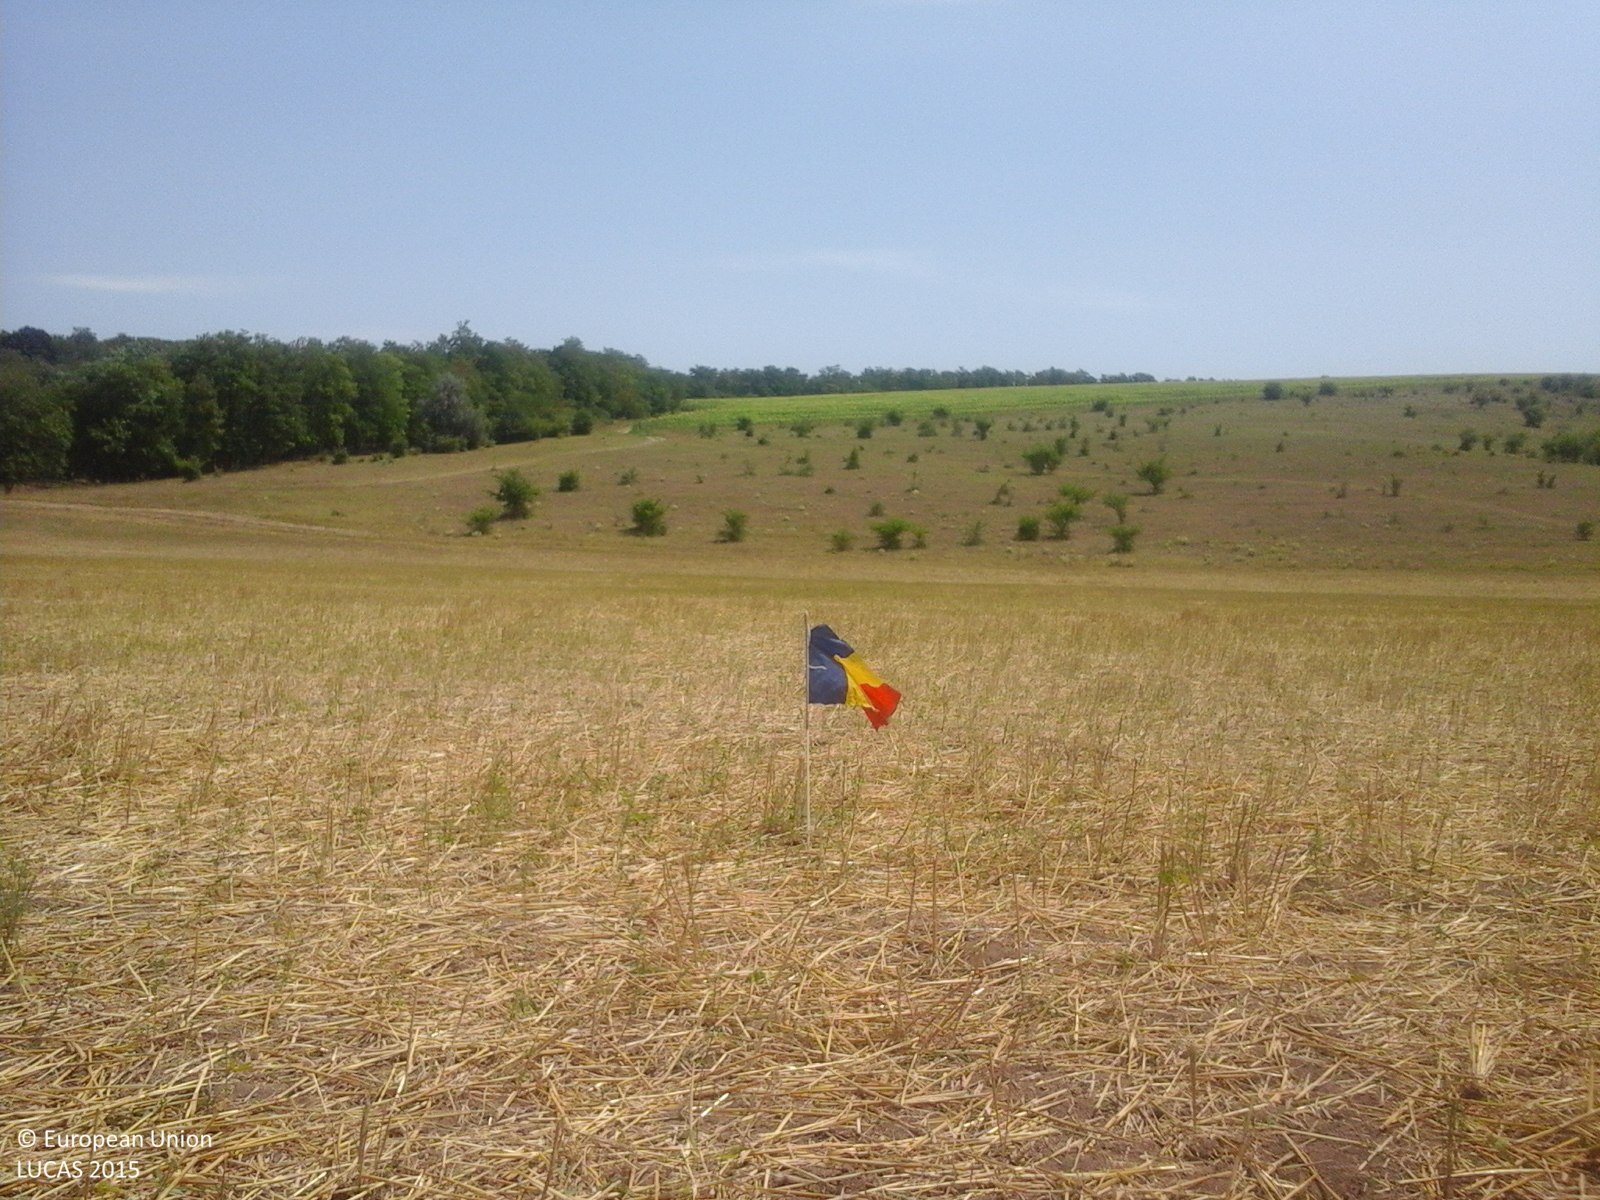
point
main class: Cropland
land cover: Common wheat
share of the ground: 25 - 50 %
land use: Agriculture (excluding fallow land and kitchen gardens)
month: August
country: RO
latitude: 44.0312
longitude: 27.8019
